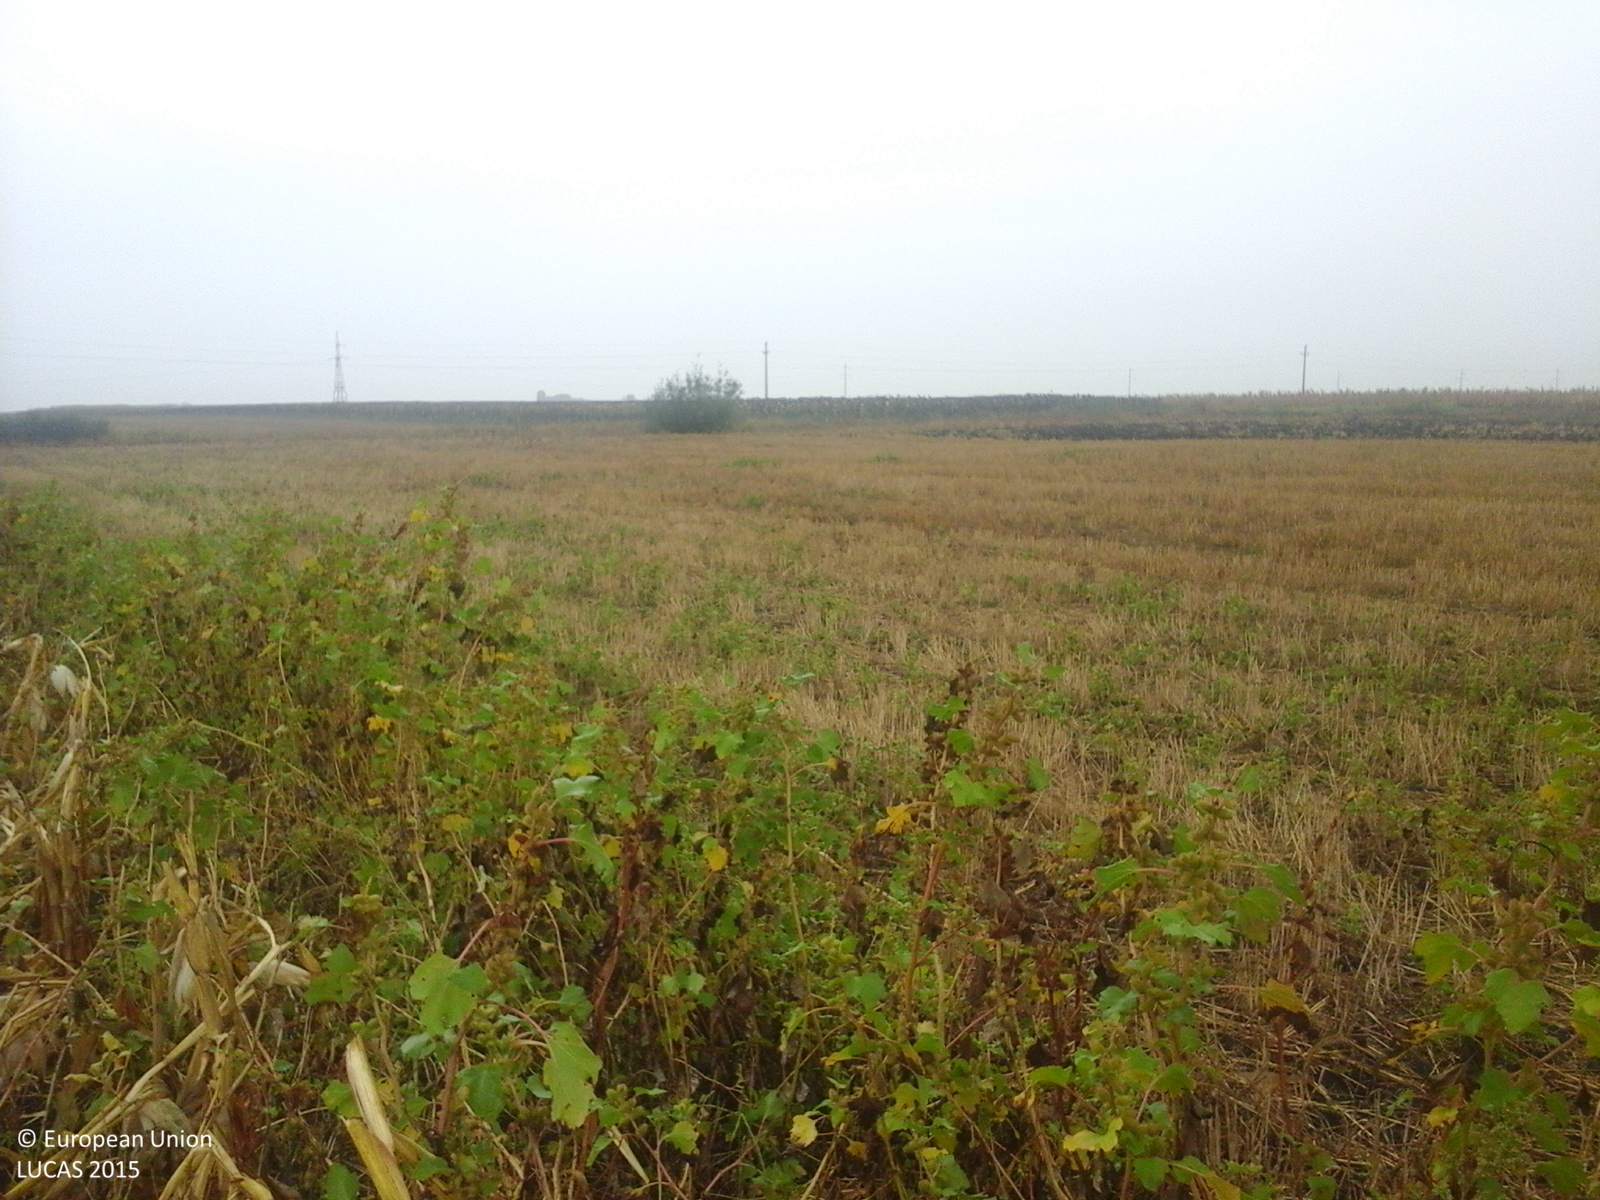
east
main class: Cropland
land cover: Maize
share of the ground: > 75 %
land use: Agriculture (excluding fallow land and kitchen gardens)
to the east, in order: Maize; Grass margins; Common wheat; Grass margins; Tracks; Grass margins; Ditches and canals; Common wheat; Sunflower; Electric lines; Sunflower; Grass margins; Tracks; Grass margins; Maize
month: September
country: RO
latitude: 47.6152
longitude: 22.5241
